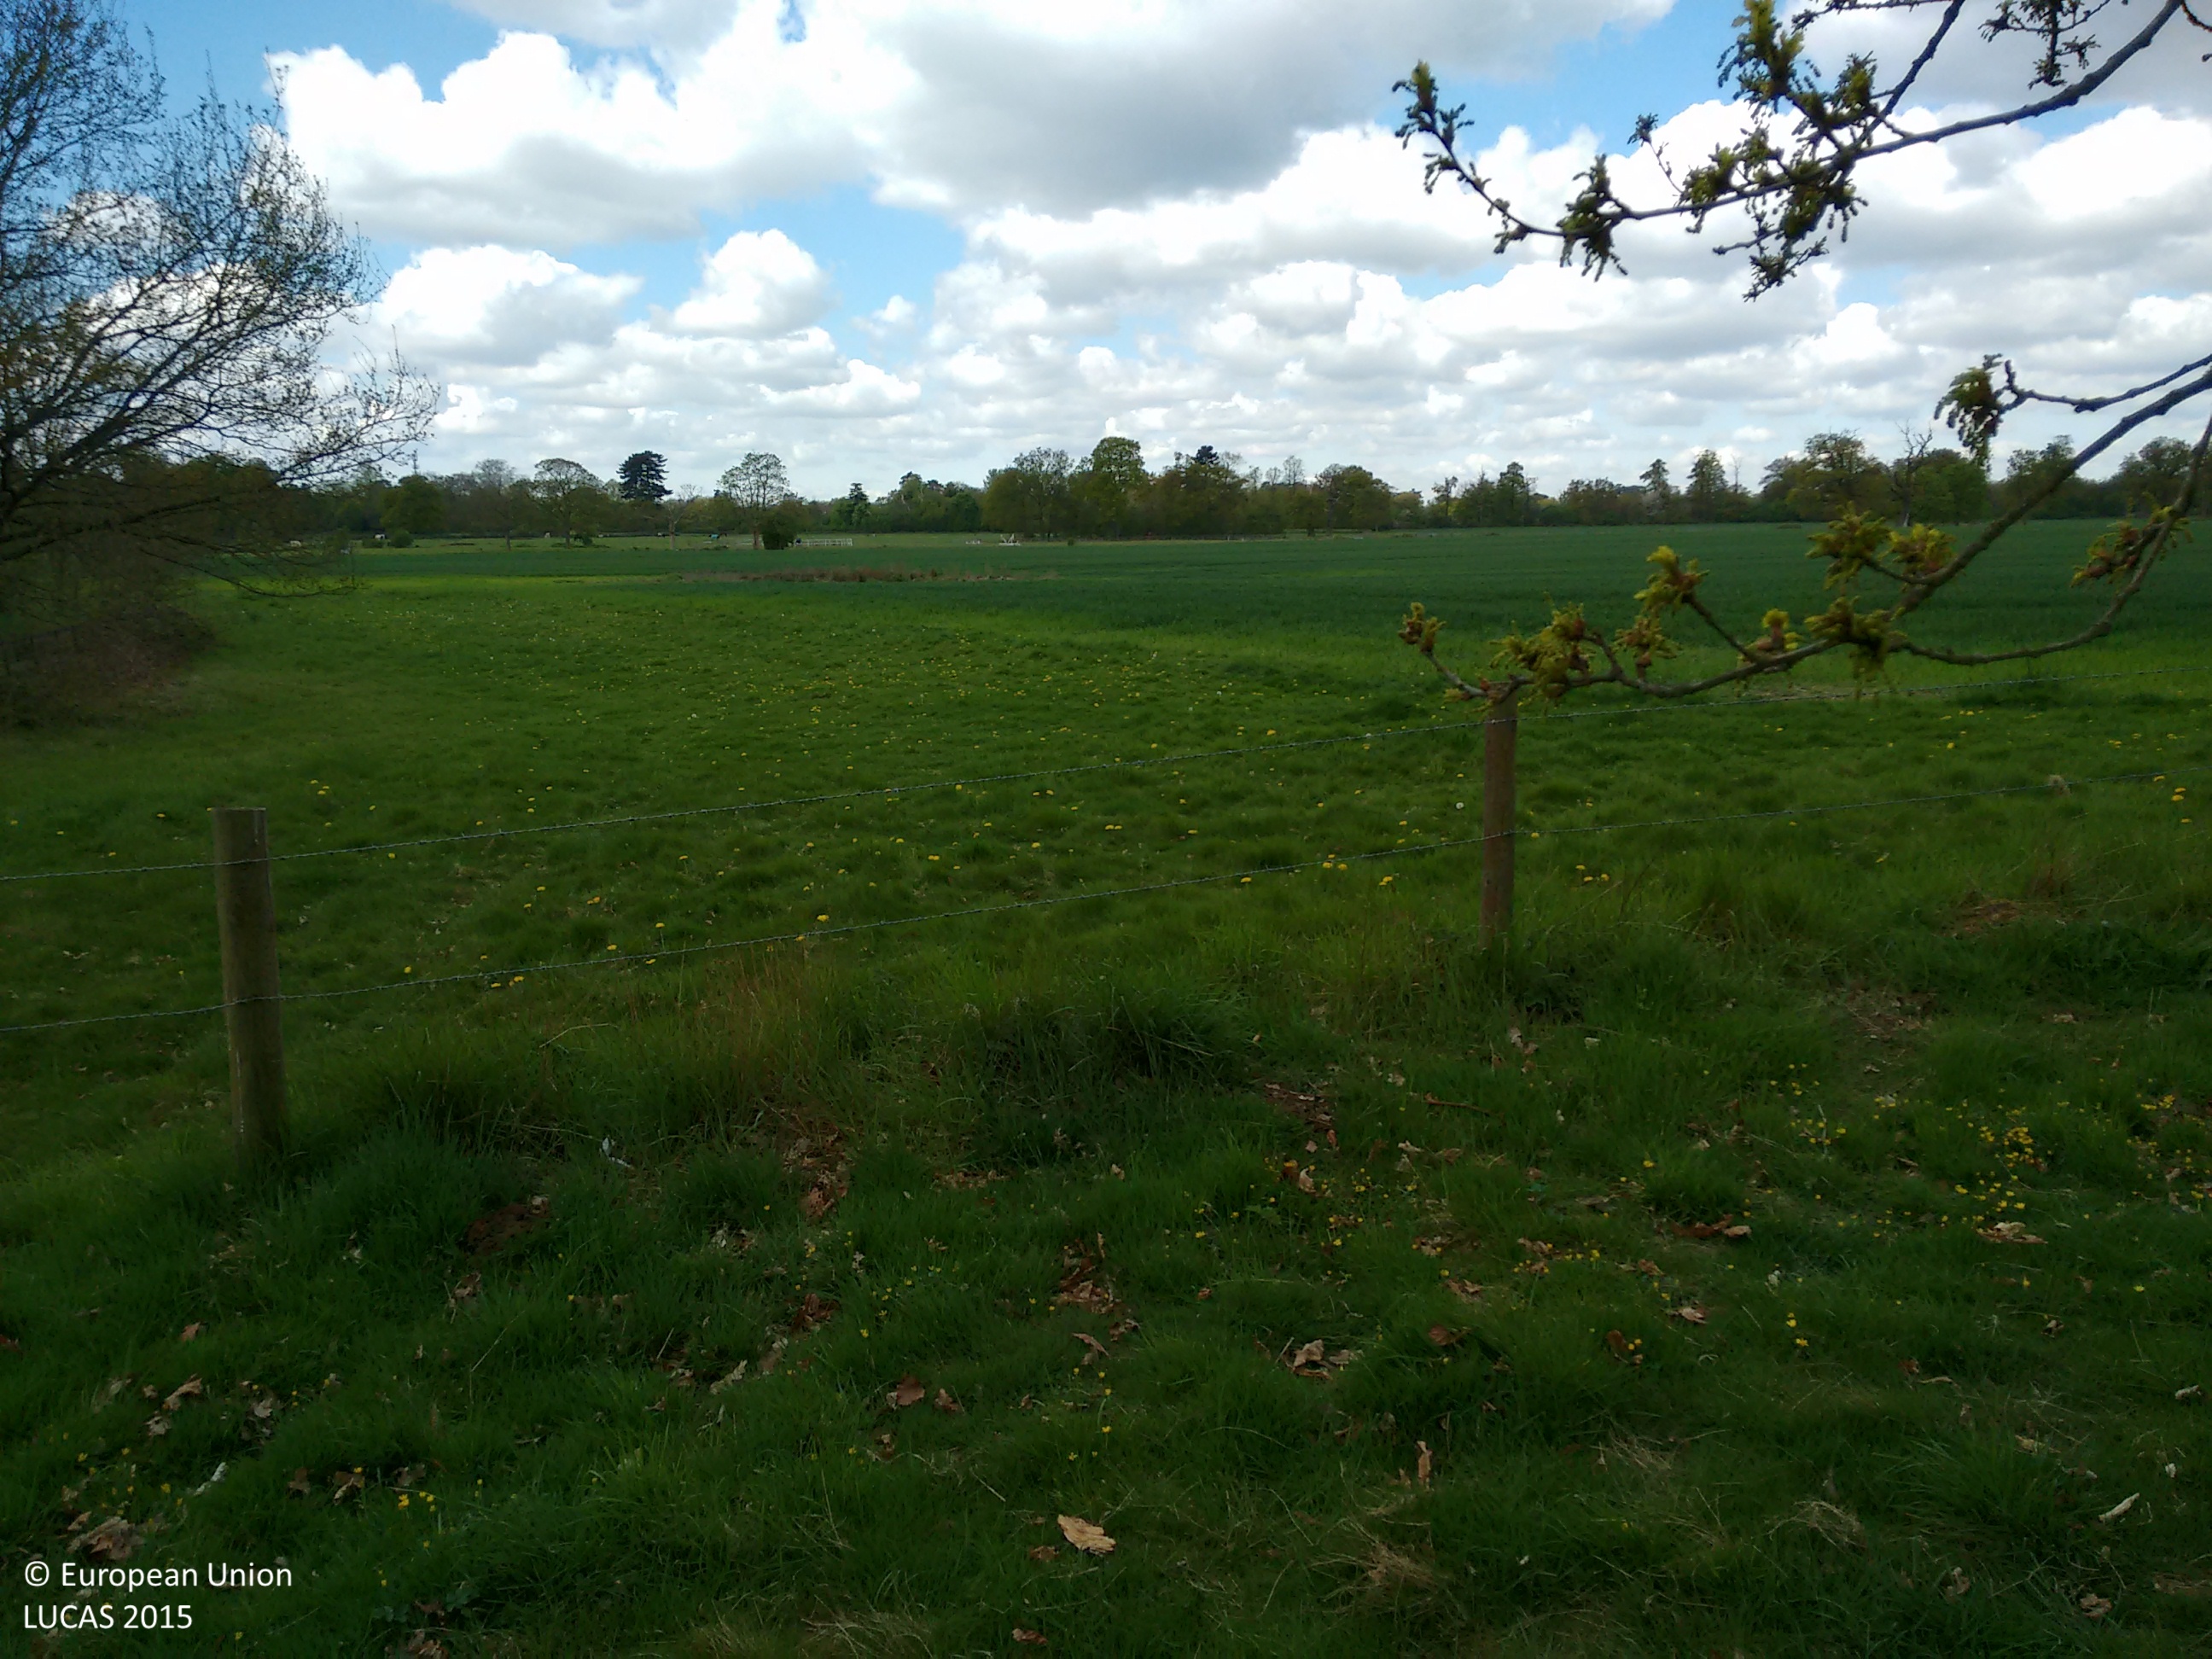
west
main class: Woodland
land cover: Broadleaved woodland
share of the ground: 50 - 75 %
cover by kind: broadleaved forest trees 50 %, herbaceous plants 50 %
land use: Residential
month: April
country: GB
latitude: 51.5255
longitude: -0.5464
